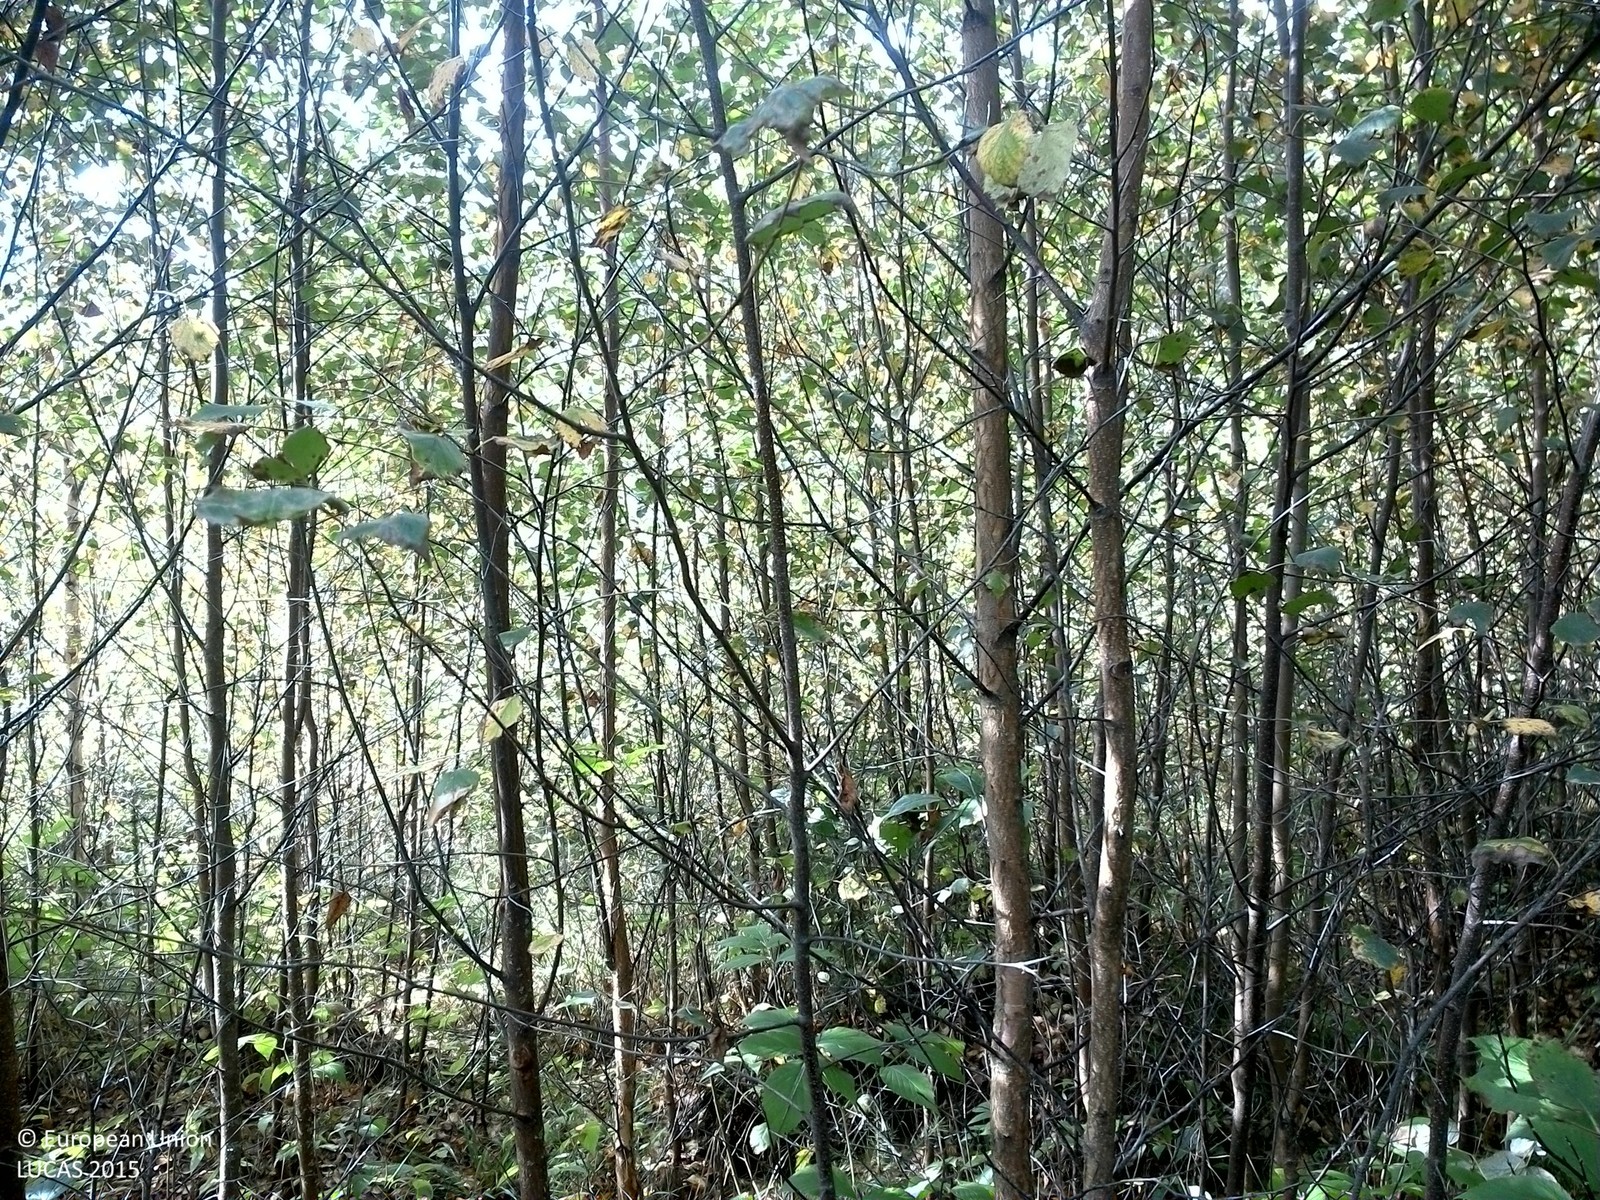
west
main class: Woodland
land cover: Spruce dominated mixed woodland
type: boreal forest
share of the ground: > 75 %
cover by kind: coniferous forest trees 40 %, broadleaved forest trees 35 %, herbaceous plants 10 %, consolidated bare surface 10 %, lichens and mosses 5 %
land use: Forestry
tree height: < 5 m
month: September
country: SE
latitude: 59.9283
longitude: 13.1941
